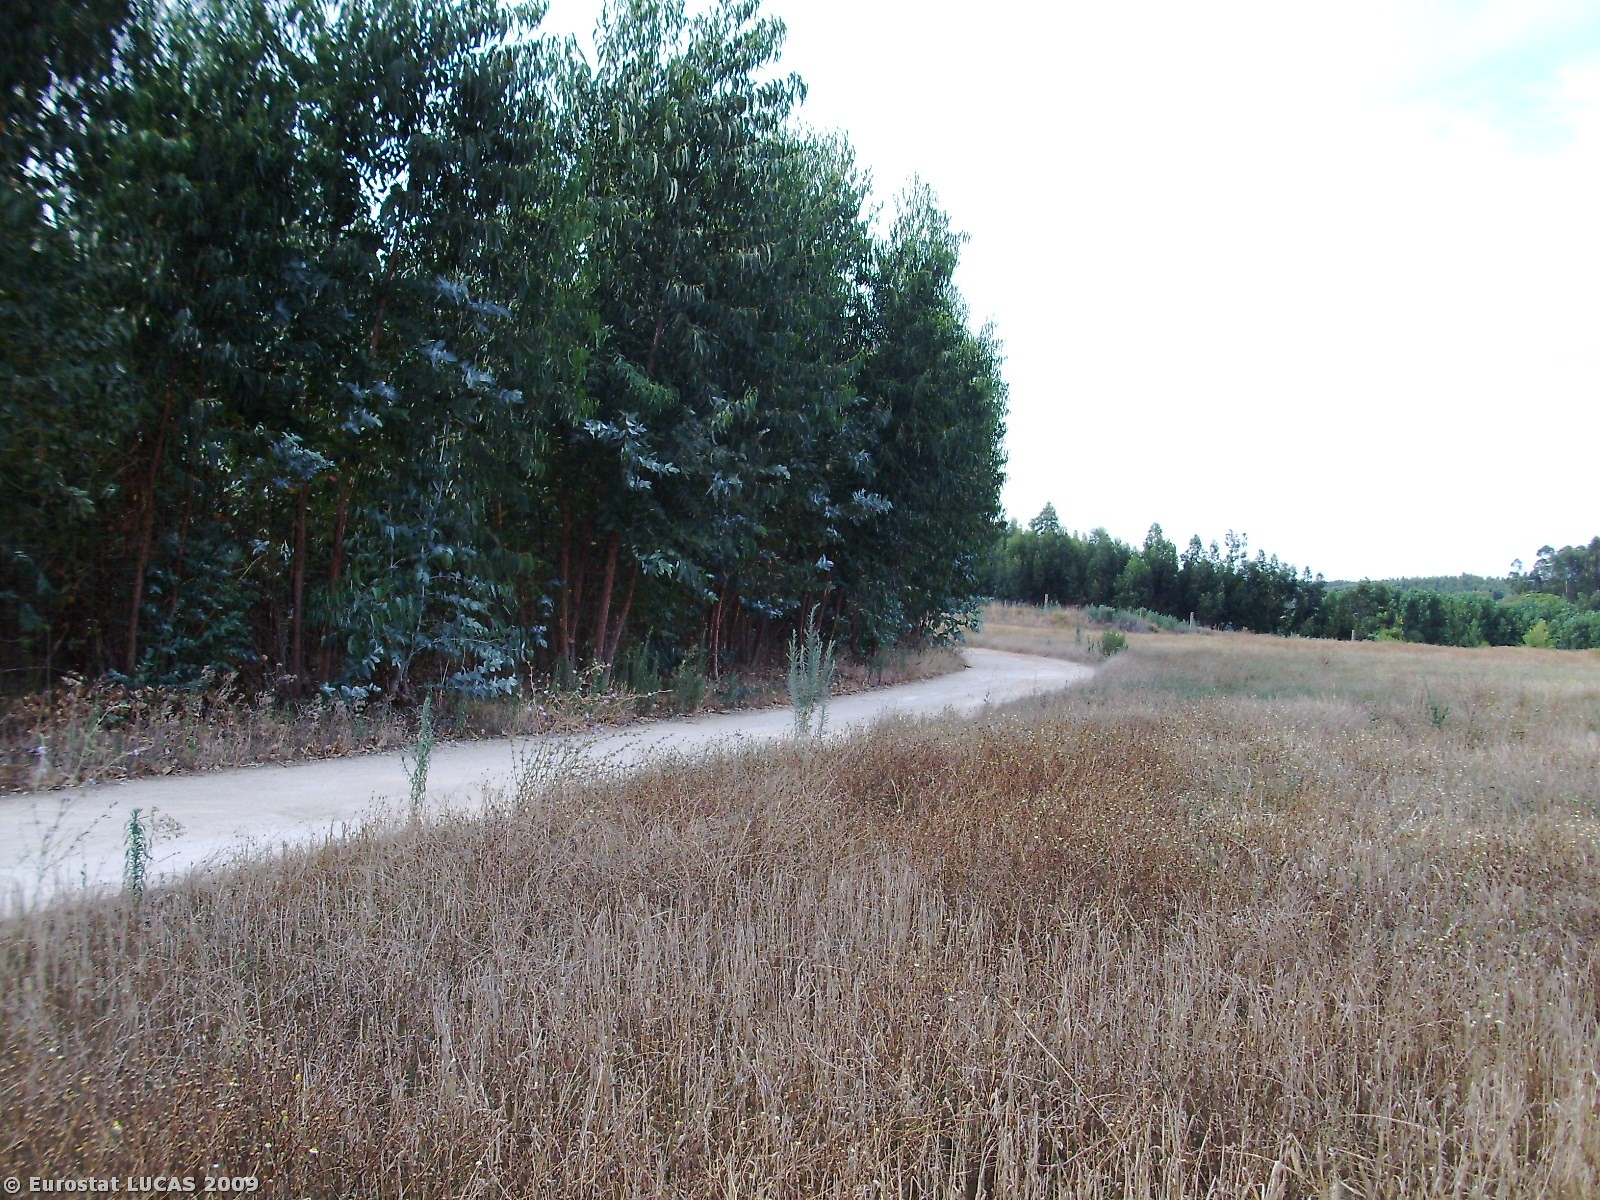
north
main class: Cropland
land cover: Barley
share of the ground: > 75 %
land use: Agriculture (excluding fallow land and kitchen gardens)
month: July
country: PT
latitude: 39.3621
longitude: -8.7749
